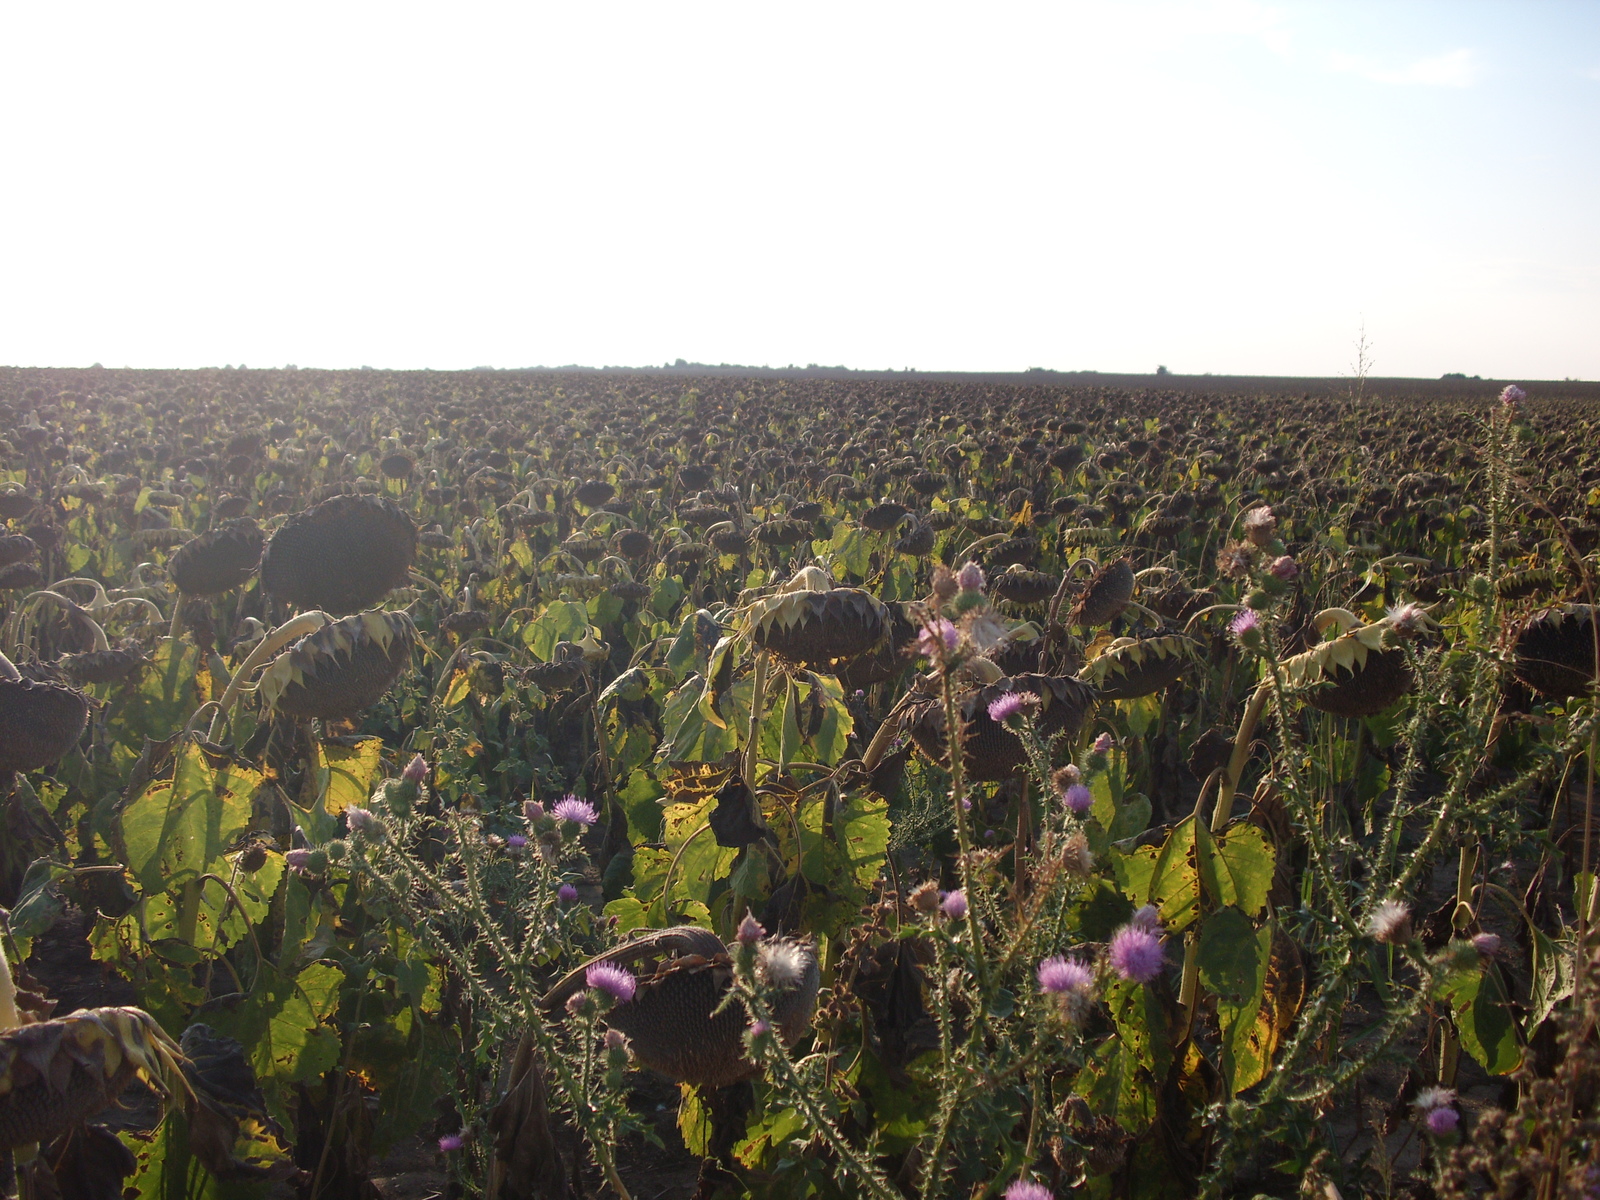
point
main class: Cropland
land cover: Sunflower
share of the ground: > 75 %
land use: Agriculture (excluding fallow land and kitchen gardens)
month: August
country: BG
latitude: 43.7193
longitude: 23.3631
